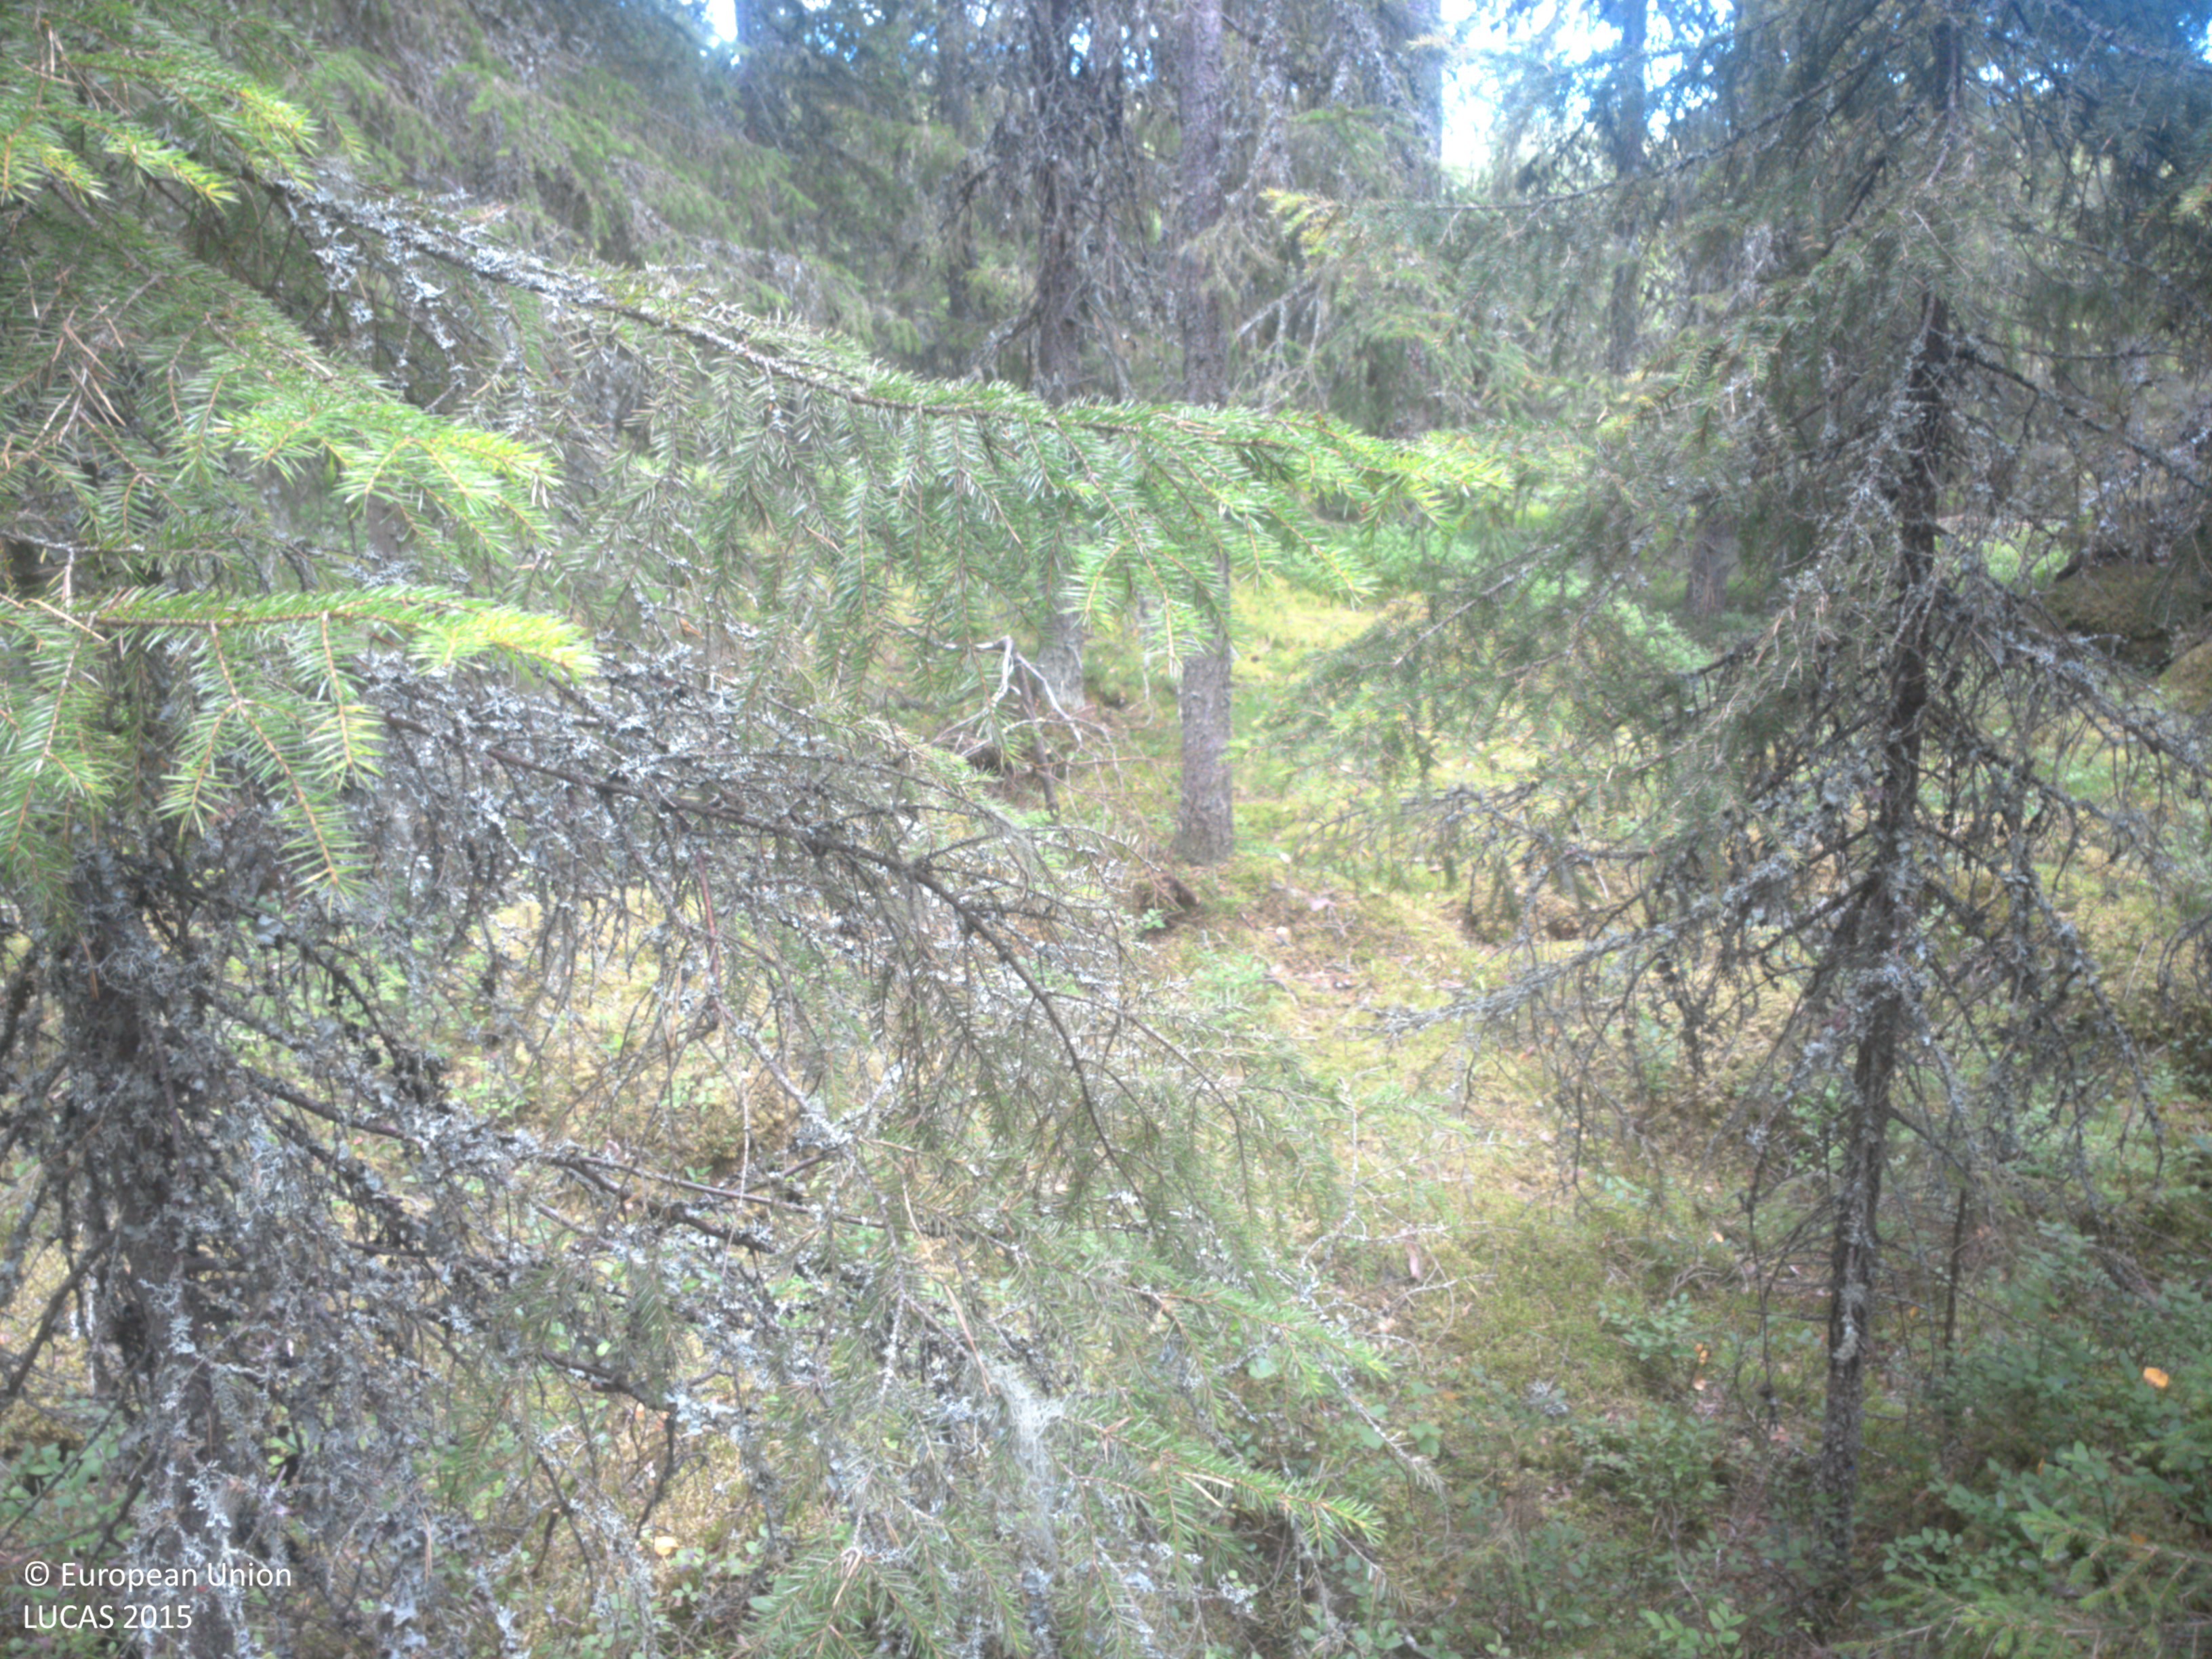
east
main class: Woodland
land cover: Other coniferous woodland
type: boreal forest
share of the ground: 50 - 75 %
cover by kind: coniferous forest trees 50 %, shrubs 50 %
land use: Forestry
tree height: > 5 m
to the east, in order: Other coniferous woodland; Spruce dominated coniferous woodland; Spruce dominated mixed woodland; Other mixed woodland; Other coniferous woodland; Spruce dominated coniferous woodland
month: August
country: SE
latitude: 63.6428
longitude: 19.4471
